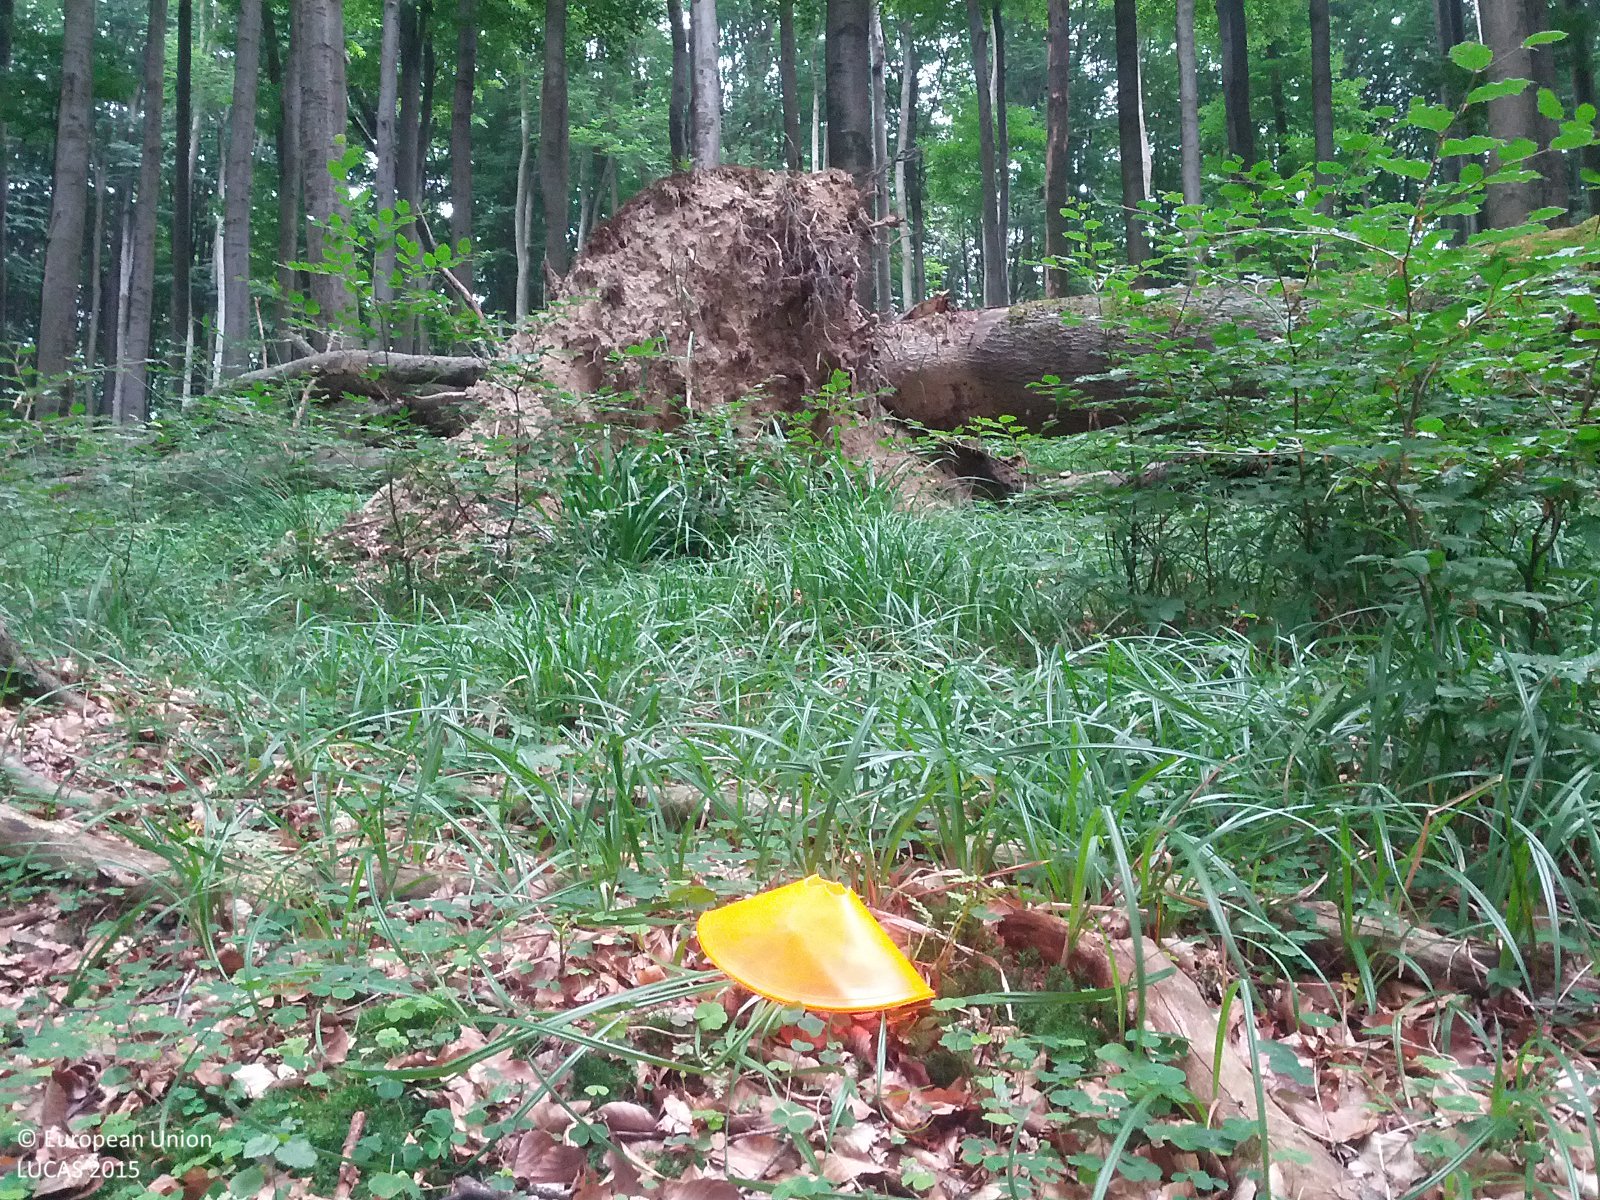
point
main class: Woodland
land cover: Broadleaved woodland
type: beech forest
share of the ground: > 75 %
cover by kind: broadleaved forest trees 65 %, herbaceous plants 30 %, shrubs 5 %
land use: Forestry
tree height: > 5 m
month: June
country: AT
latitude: 48.2185
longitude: 16.0742
